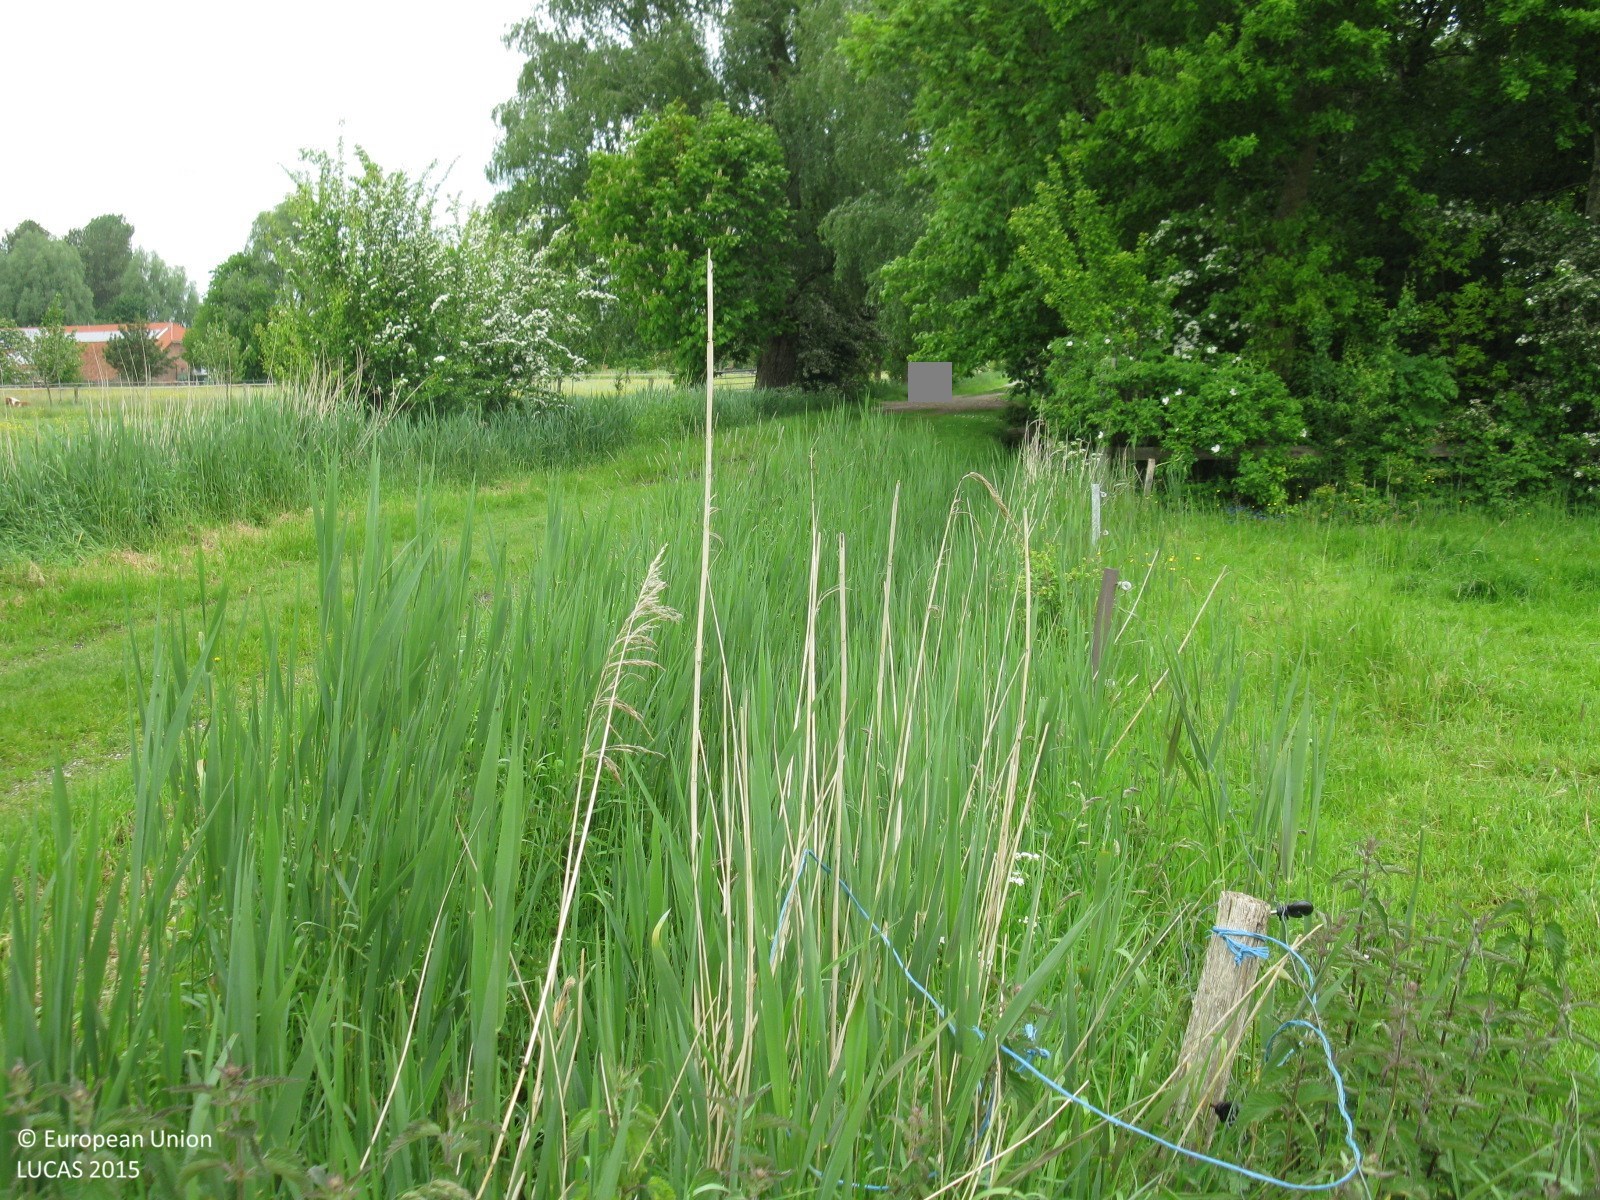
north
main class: Grassland
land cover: Grassland without tree/shrub cover
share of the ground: > 75 %
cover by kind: herbaceous plants 100 %
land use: Agriculture (excluding fallow land and kitchen gardens)
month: June
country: DE
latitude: 53.1566
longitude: 7.3236
